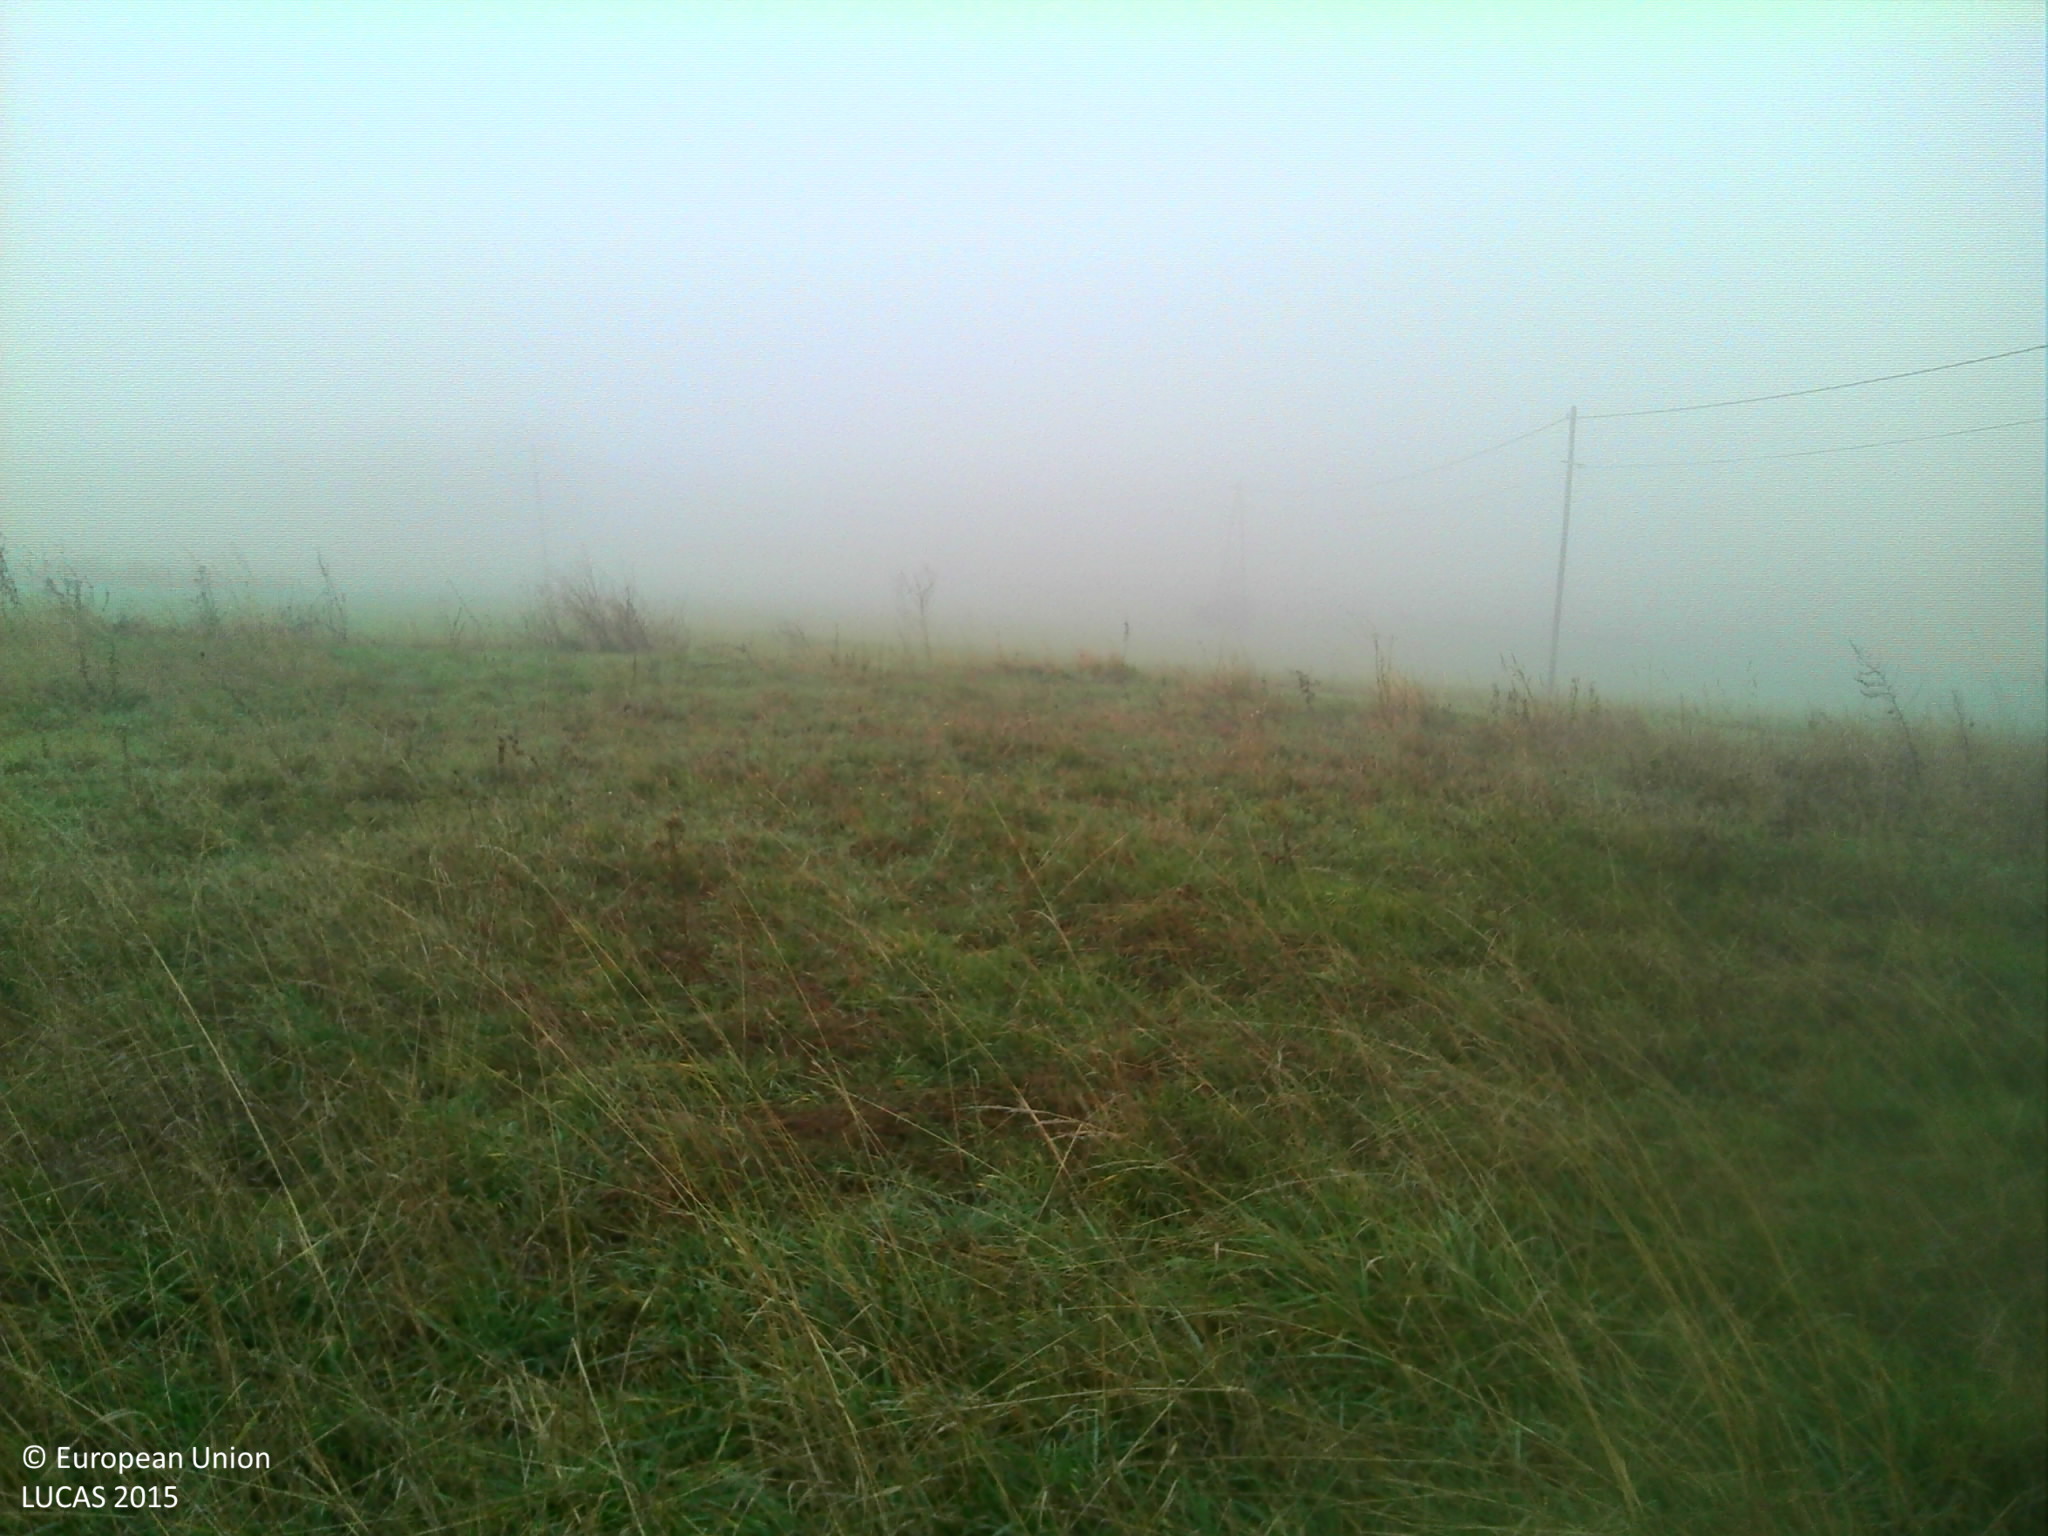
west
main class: Grassland
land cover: Grassland without tree/shrub cover
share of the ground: > 75 %
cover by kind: herbaceous plants 100 %
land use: Agriculture (excluding fallow land and kitchen gardens)
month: December
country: FR
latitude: 45.1707
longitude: 5.0302
